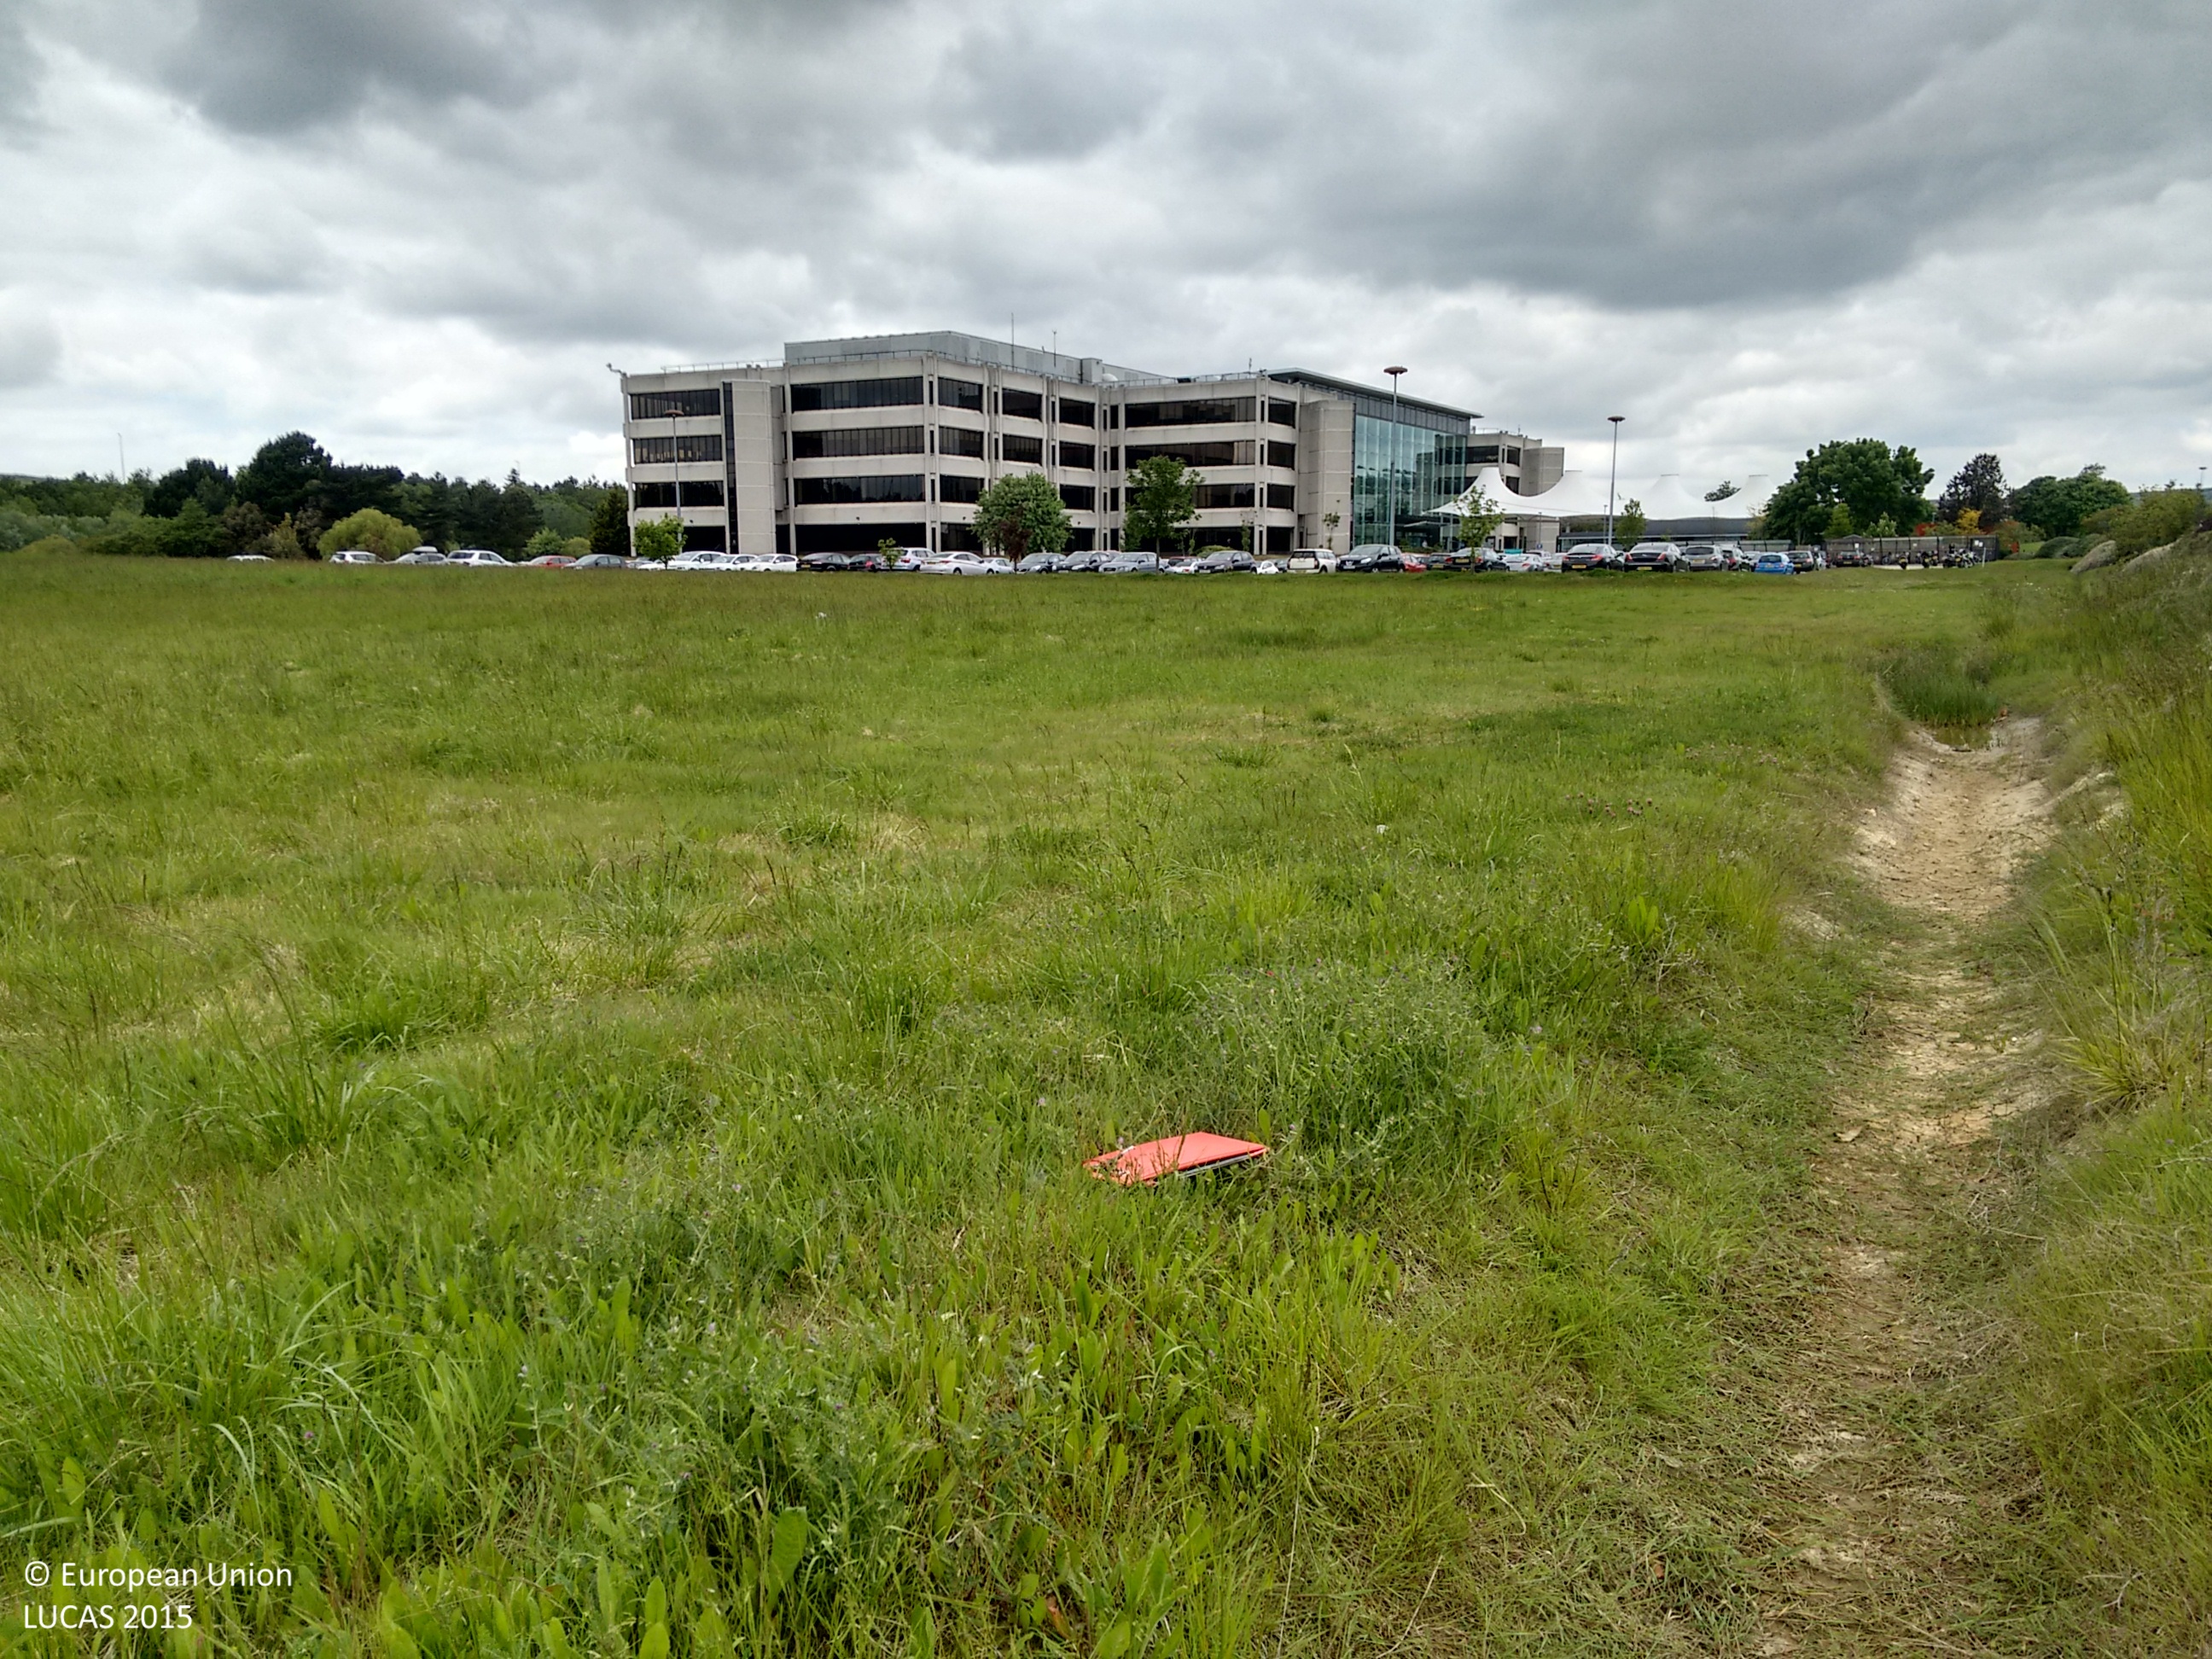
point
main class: Grassland
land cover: Grassland without tree/shrub cover
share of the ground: > 75 %
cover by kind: herbaceous plants 100 %
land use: Semi-natural and natural areas not in use
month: May
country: GB
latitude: 50.8405
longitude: -1.0795
